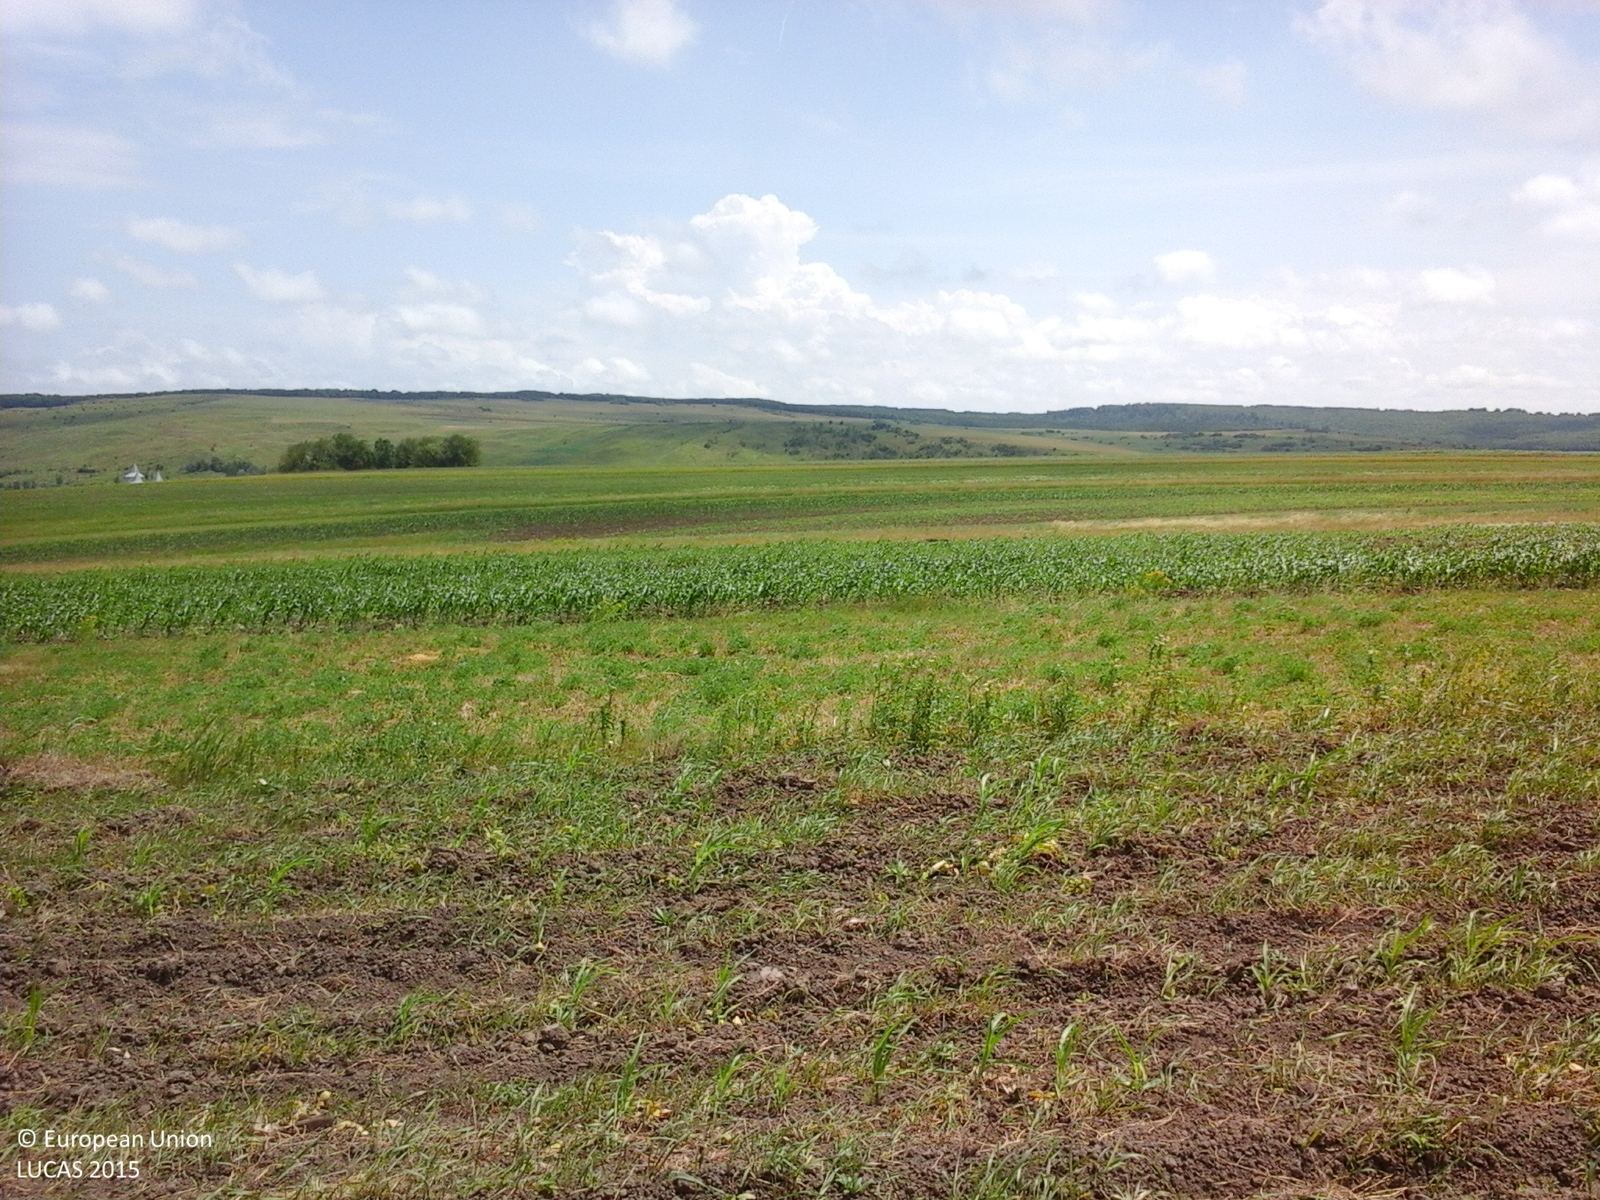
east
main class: Cropland
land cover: Maize
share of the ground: 25 - 50 %
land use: Agriculture (excluding fallow land and kitchen gardens)
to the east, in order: Maize; Other leguminous and mixtures for fodder; Maize; Grassland without tree/shrub cover; Oats; Grassland without tree/shrub cover; Maize; Grassland without tree/shrub cover; Maize; Common wheat
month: May
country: RO
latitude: 47.1459
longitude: 26.4231
